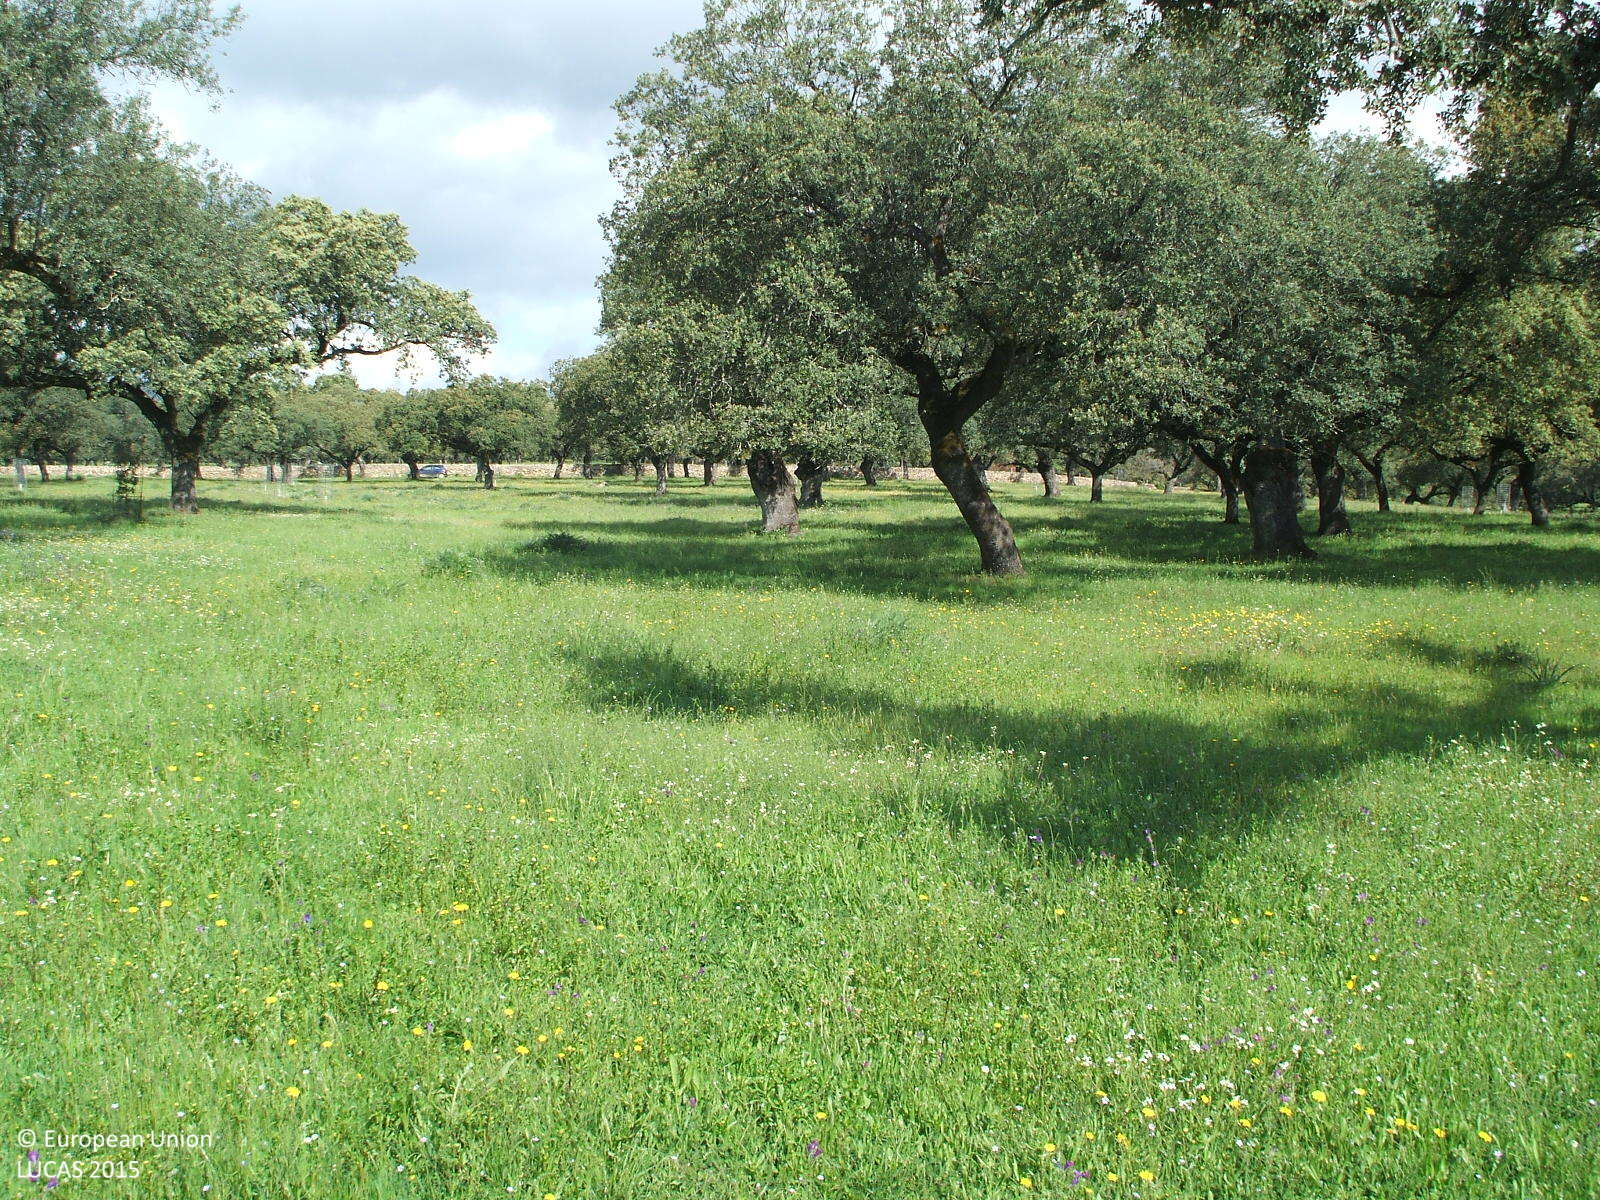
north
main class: Woodland
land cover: Broadleaved woodland
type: broadleaved evergreen forest
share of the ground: 25 - 50 %
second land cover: Grassland without tree/shrub cover
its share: > 75 %
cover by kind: herbaceous plants 75 %, broadleaved forest trees 25 %
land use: Forestry
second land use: Agriculture (excluding fallow land and kitchen gardens)
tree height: > 5 m
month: April
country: ES
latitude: 37.9967
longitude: -6.2669
